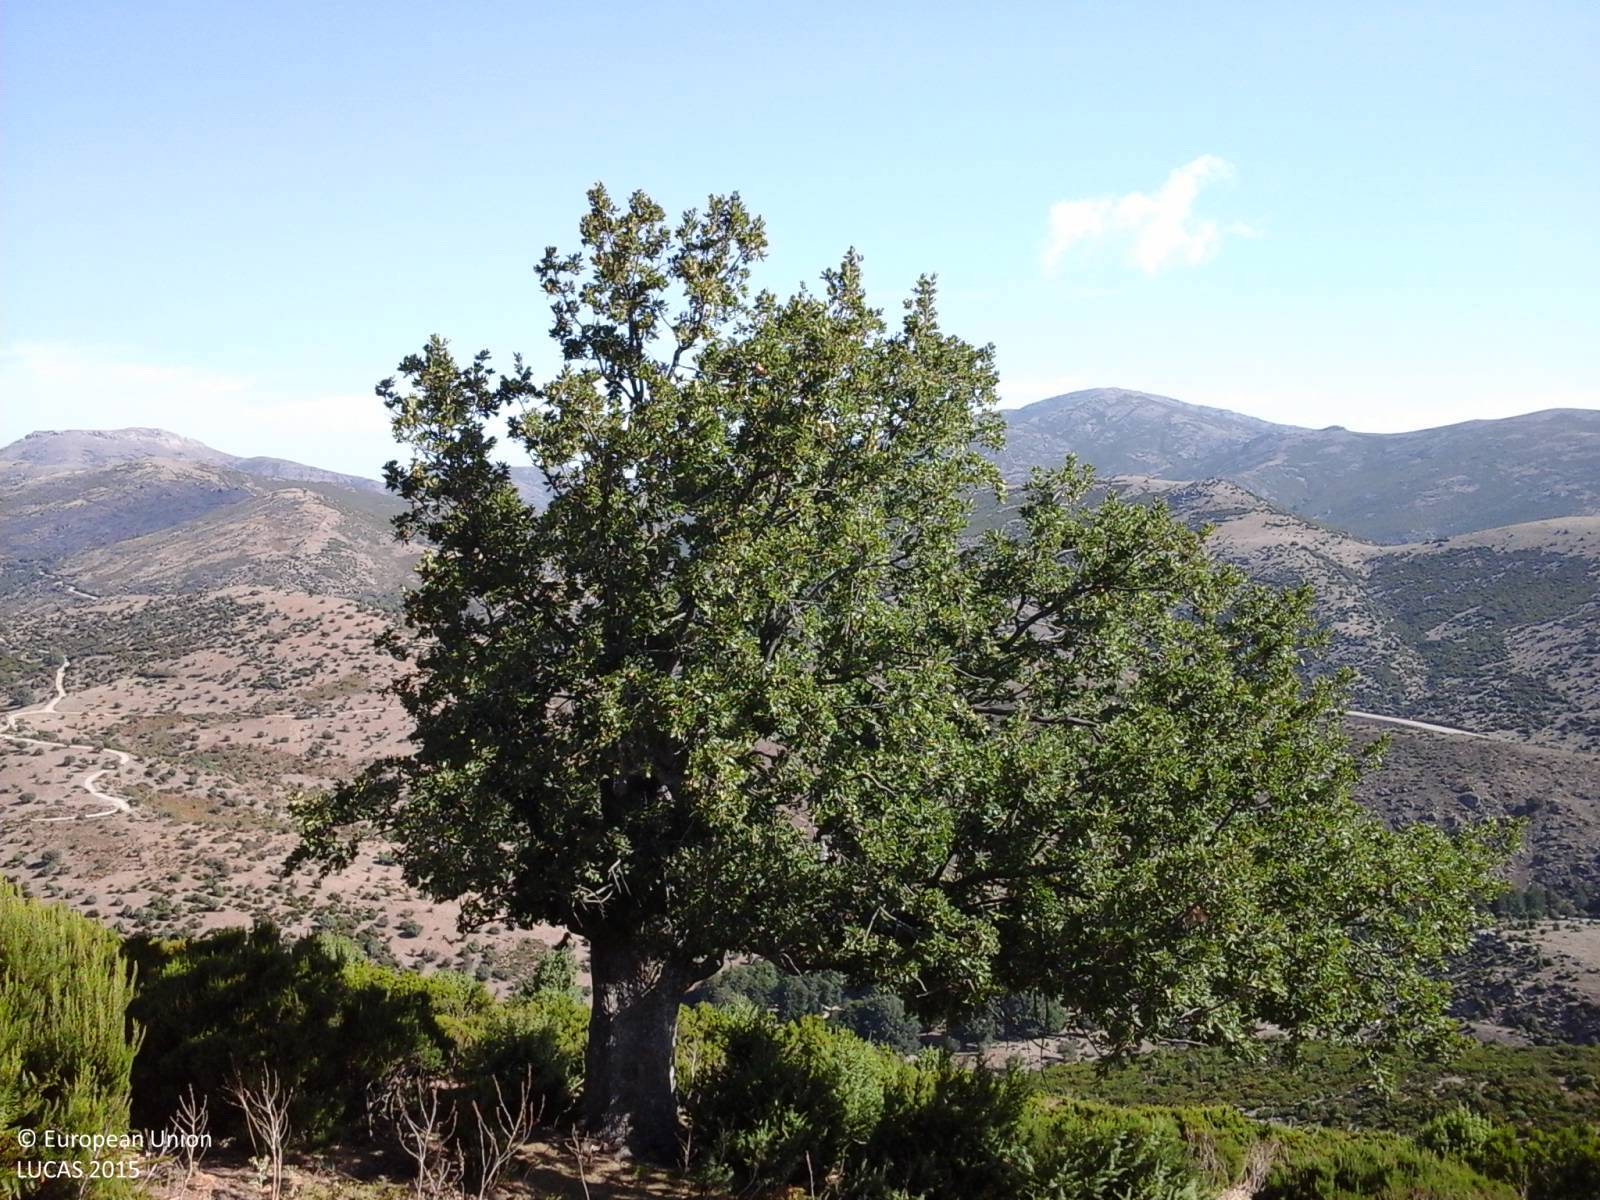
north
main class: Shrubland
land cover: Shrubland with sparse tree cover
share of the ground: > 75 %
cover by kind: shrubs 30 %, unconsolidated bare surface 30 %, herbaceous plants 20 %, consolidated bare surface 15 %, broadleaved forest trees 5 %
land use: Agriculture (excluding fallow land and kitchen gardens)
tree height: < 5 m
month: September
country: IT
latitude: 40.0119
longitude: 9.3825
